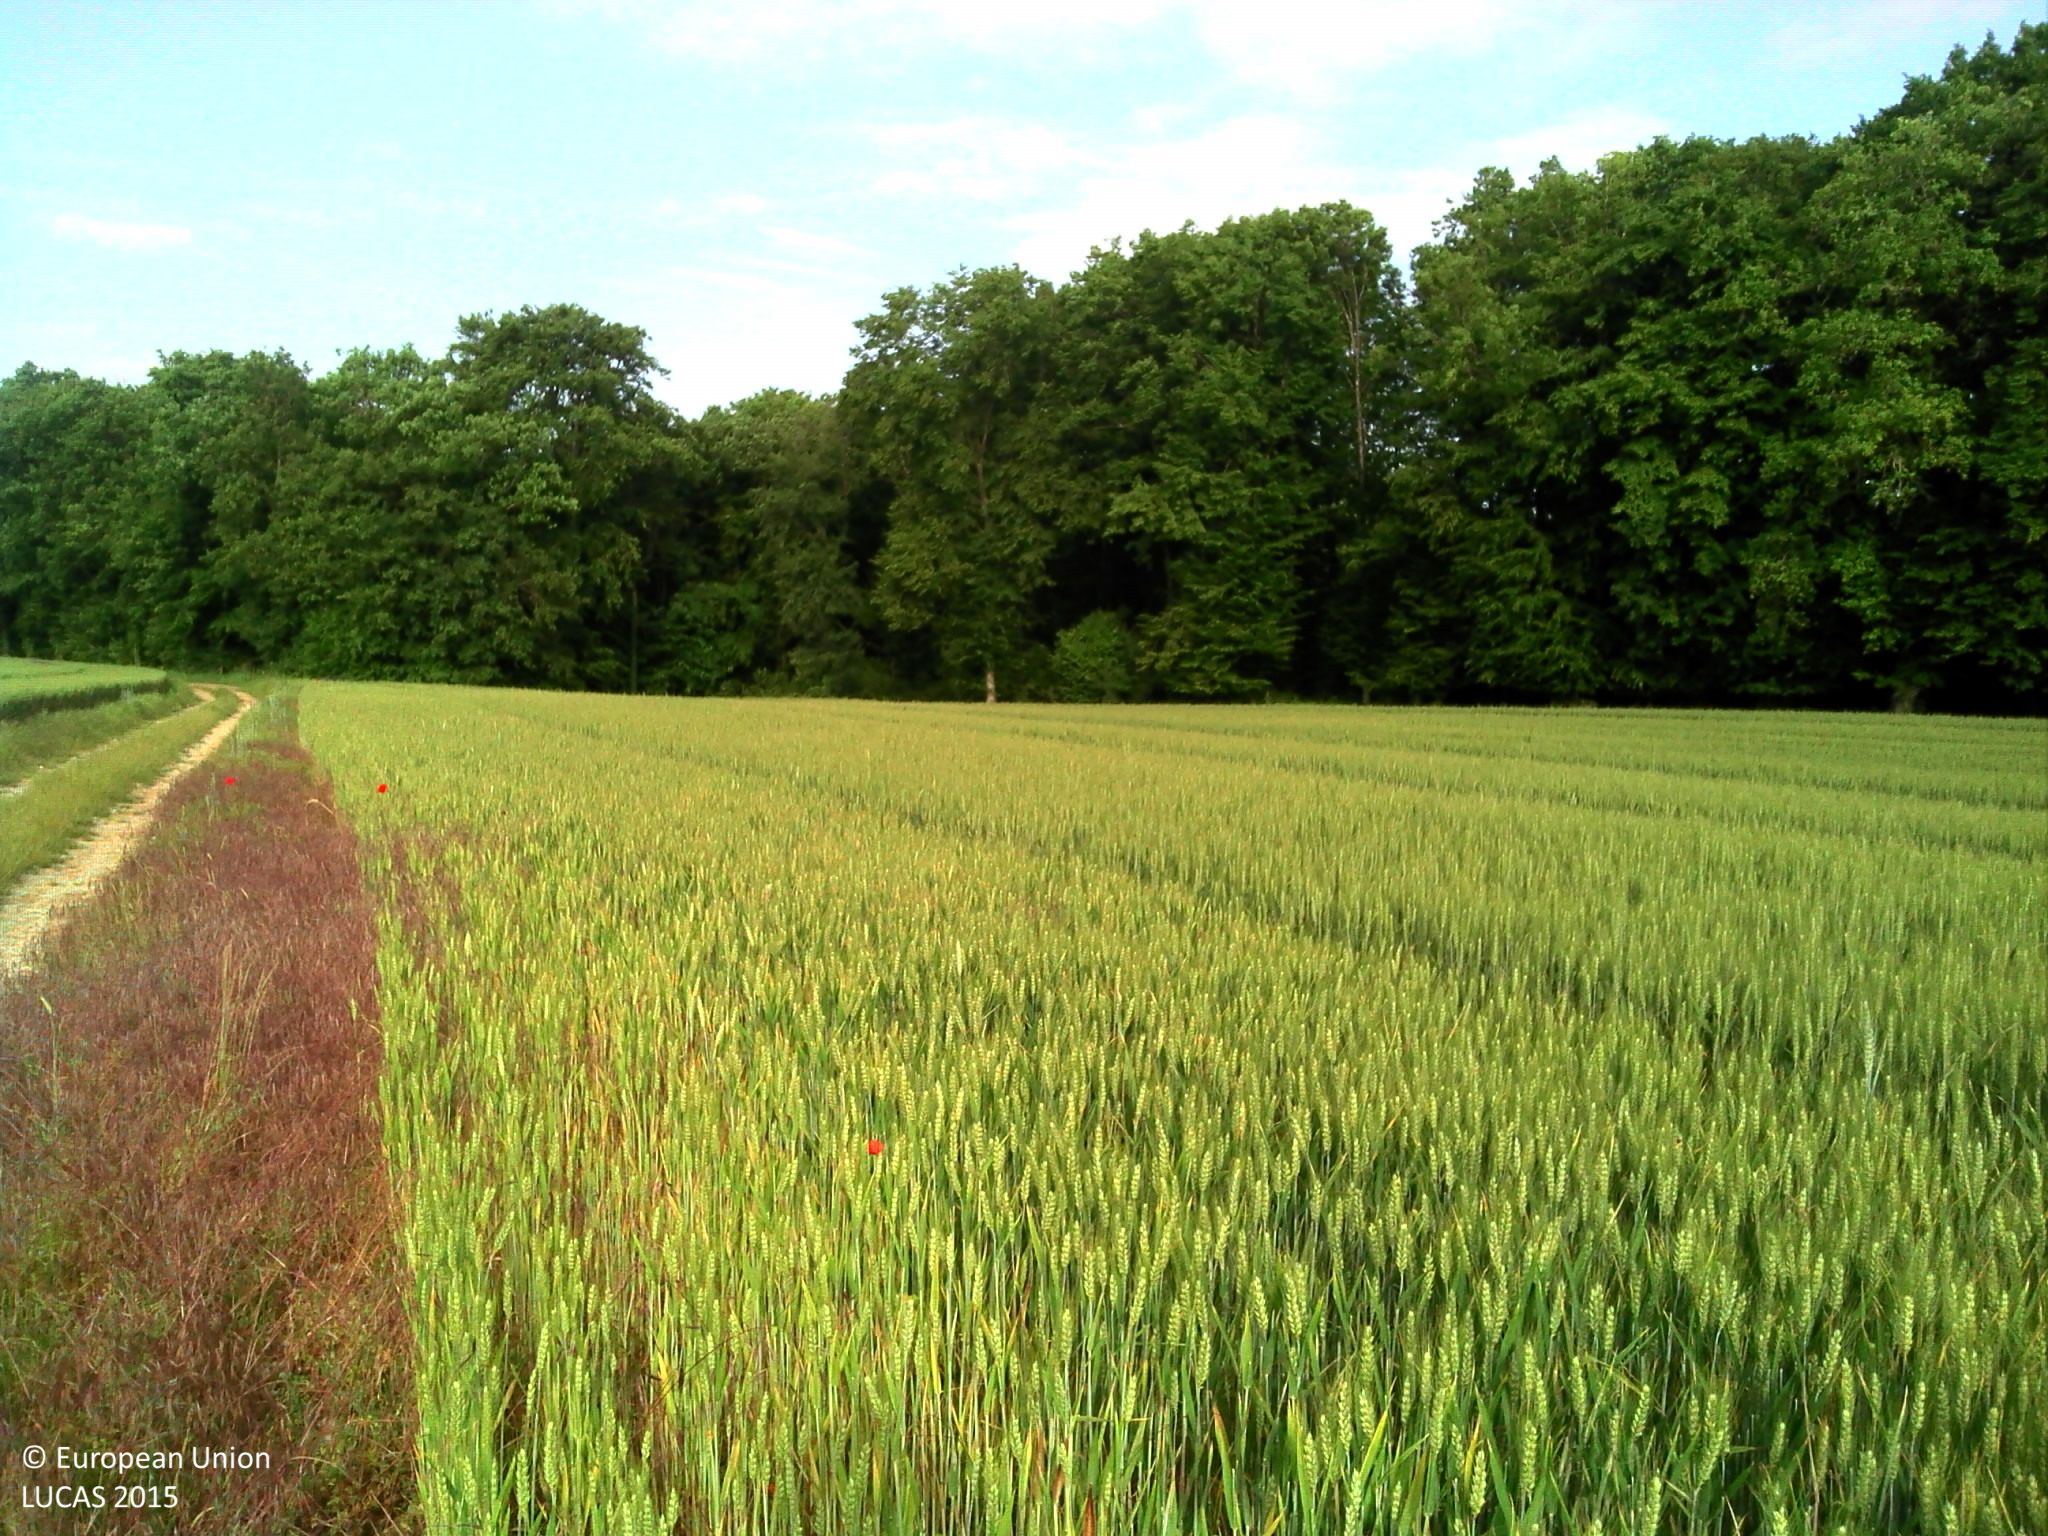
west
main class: Cropland
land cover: Common wheat
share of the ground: > 75 %
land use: Agriculture (excluding fallow land and kitchen gardens)
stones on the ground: 10 - 25 %
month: June
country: FR
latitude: 48.4782
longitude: 5.1693
